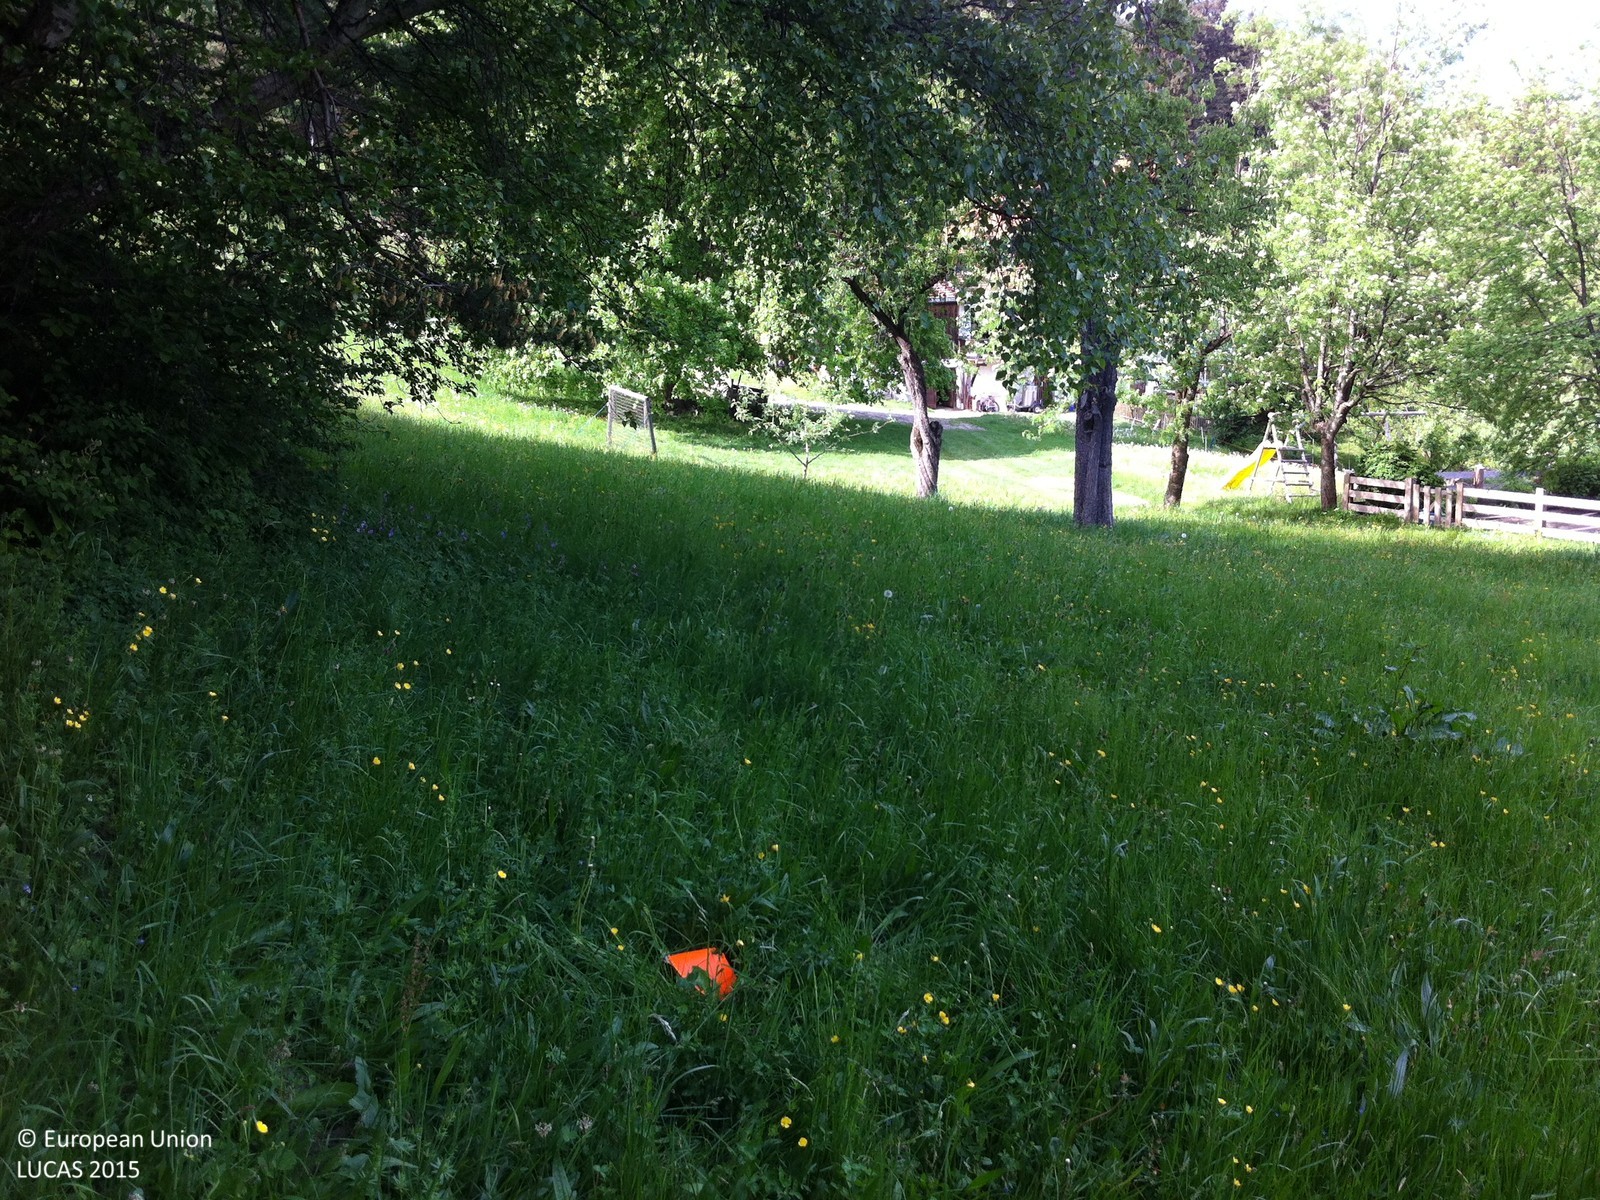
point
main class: Grassland
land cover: Grassland without tree/shrub cover
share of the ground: > 75 %
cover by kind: herbaceous plants 100 %
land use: Agriculture (excluding fallow land and kitchen gardens)
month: May
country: AT
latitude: 47.2427
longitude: 11.3859
